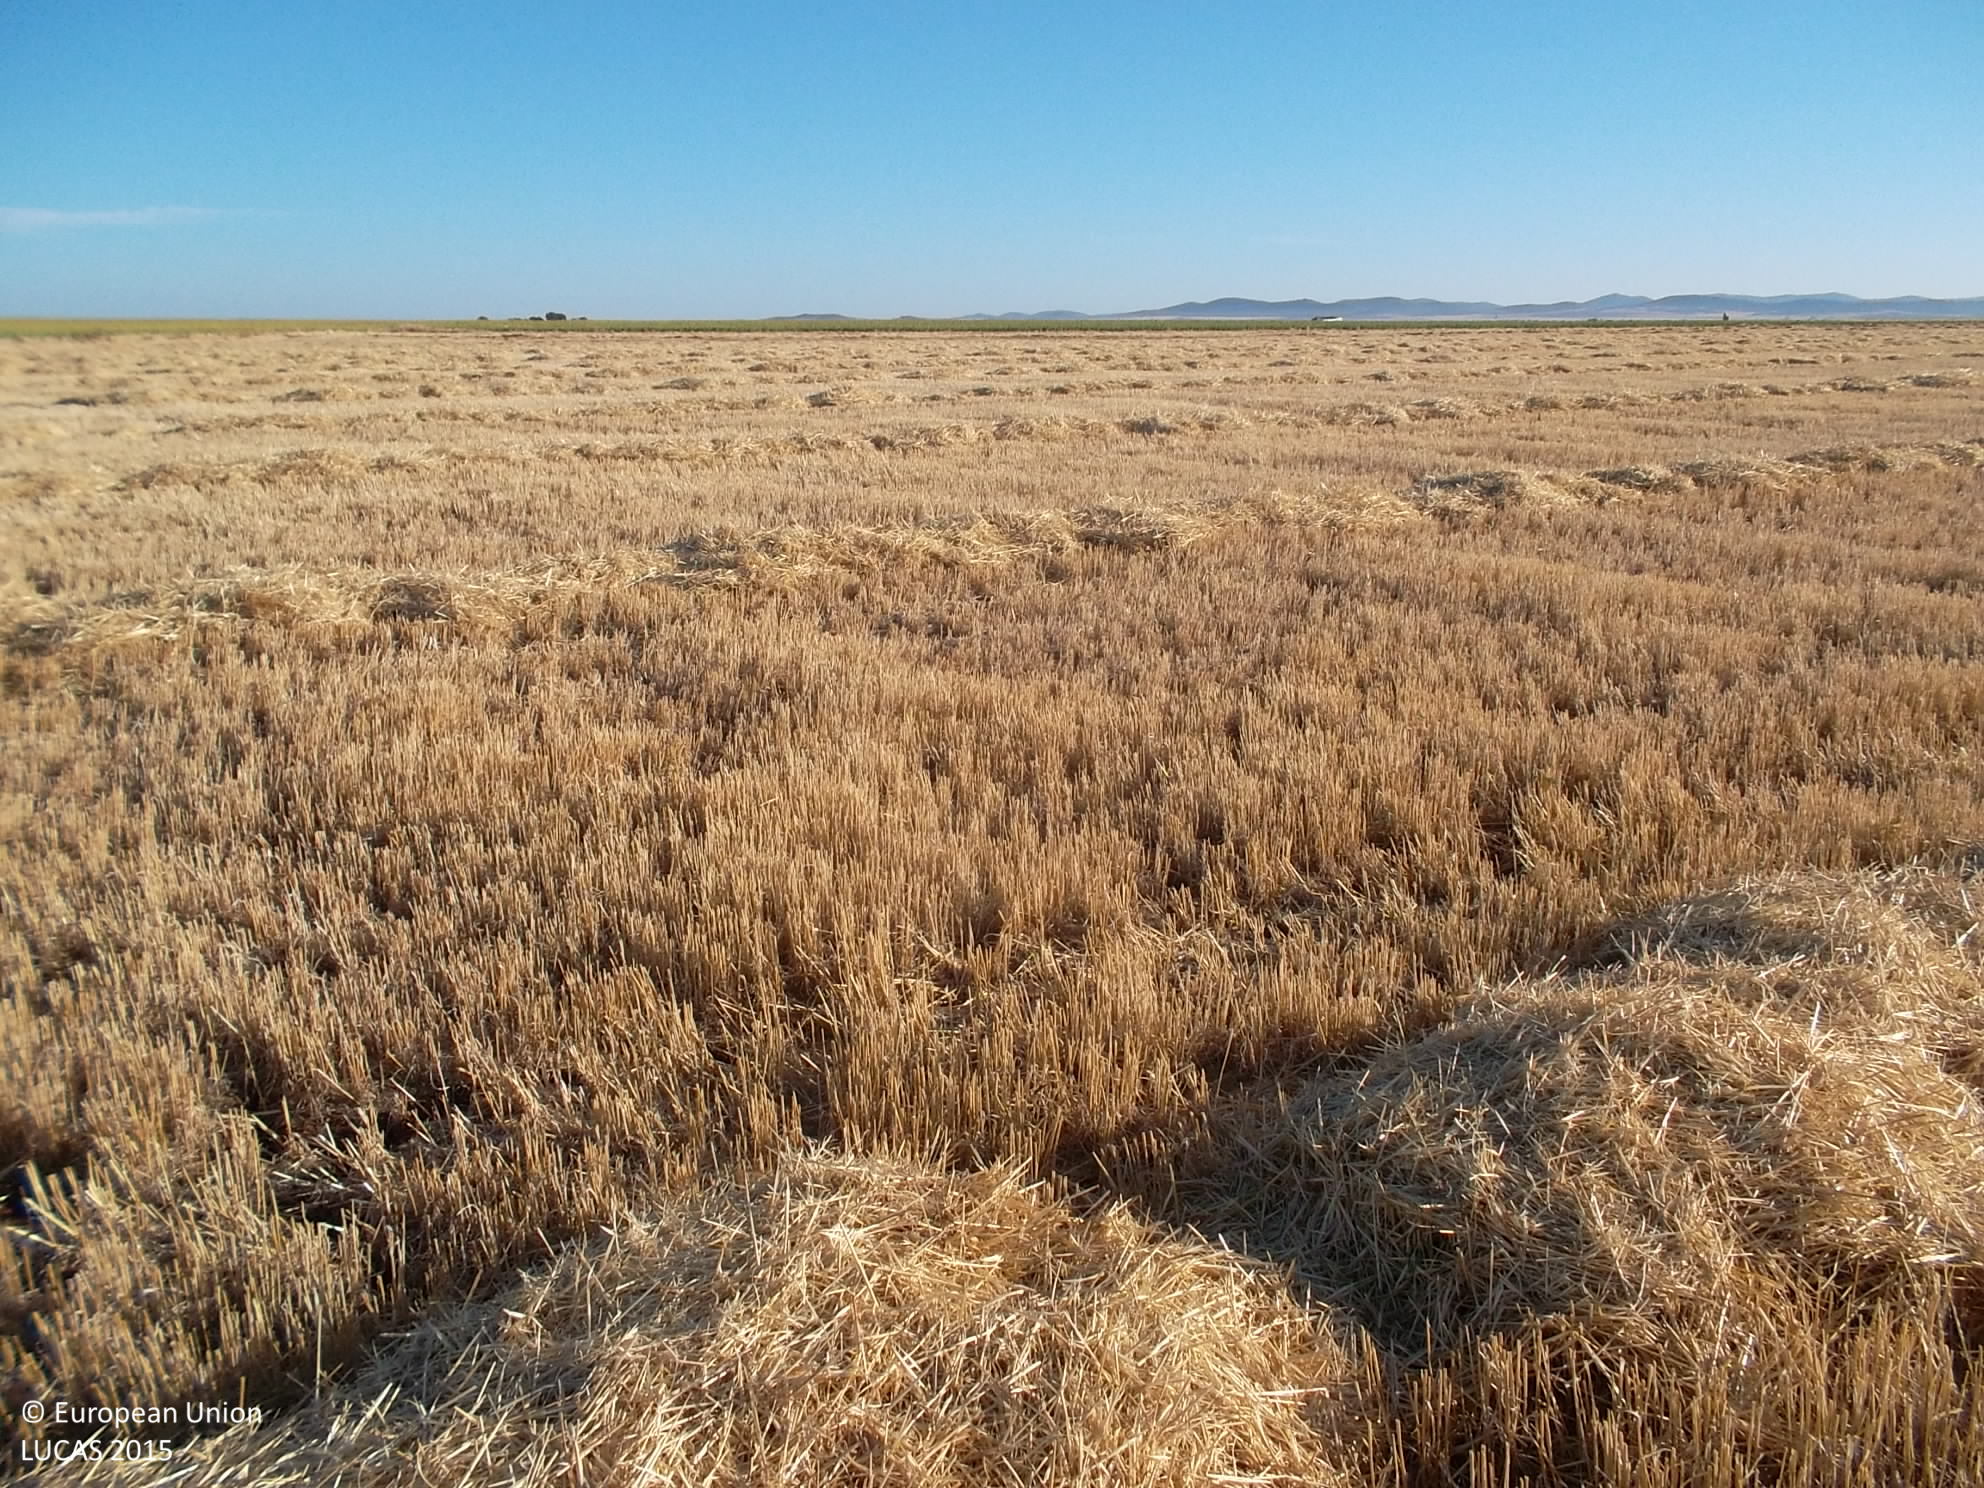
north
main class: Cropland
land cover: Barley
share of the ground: < 10 %
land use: Agriculture (excluding fallow land and kitchen gardens)
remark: Harvested field
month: July
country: ES
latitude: 38.3325
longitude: -5.6970
